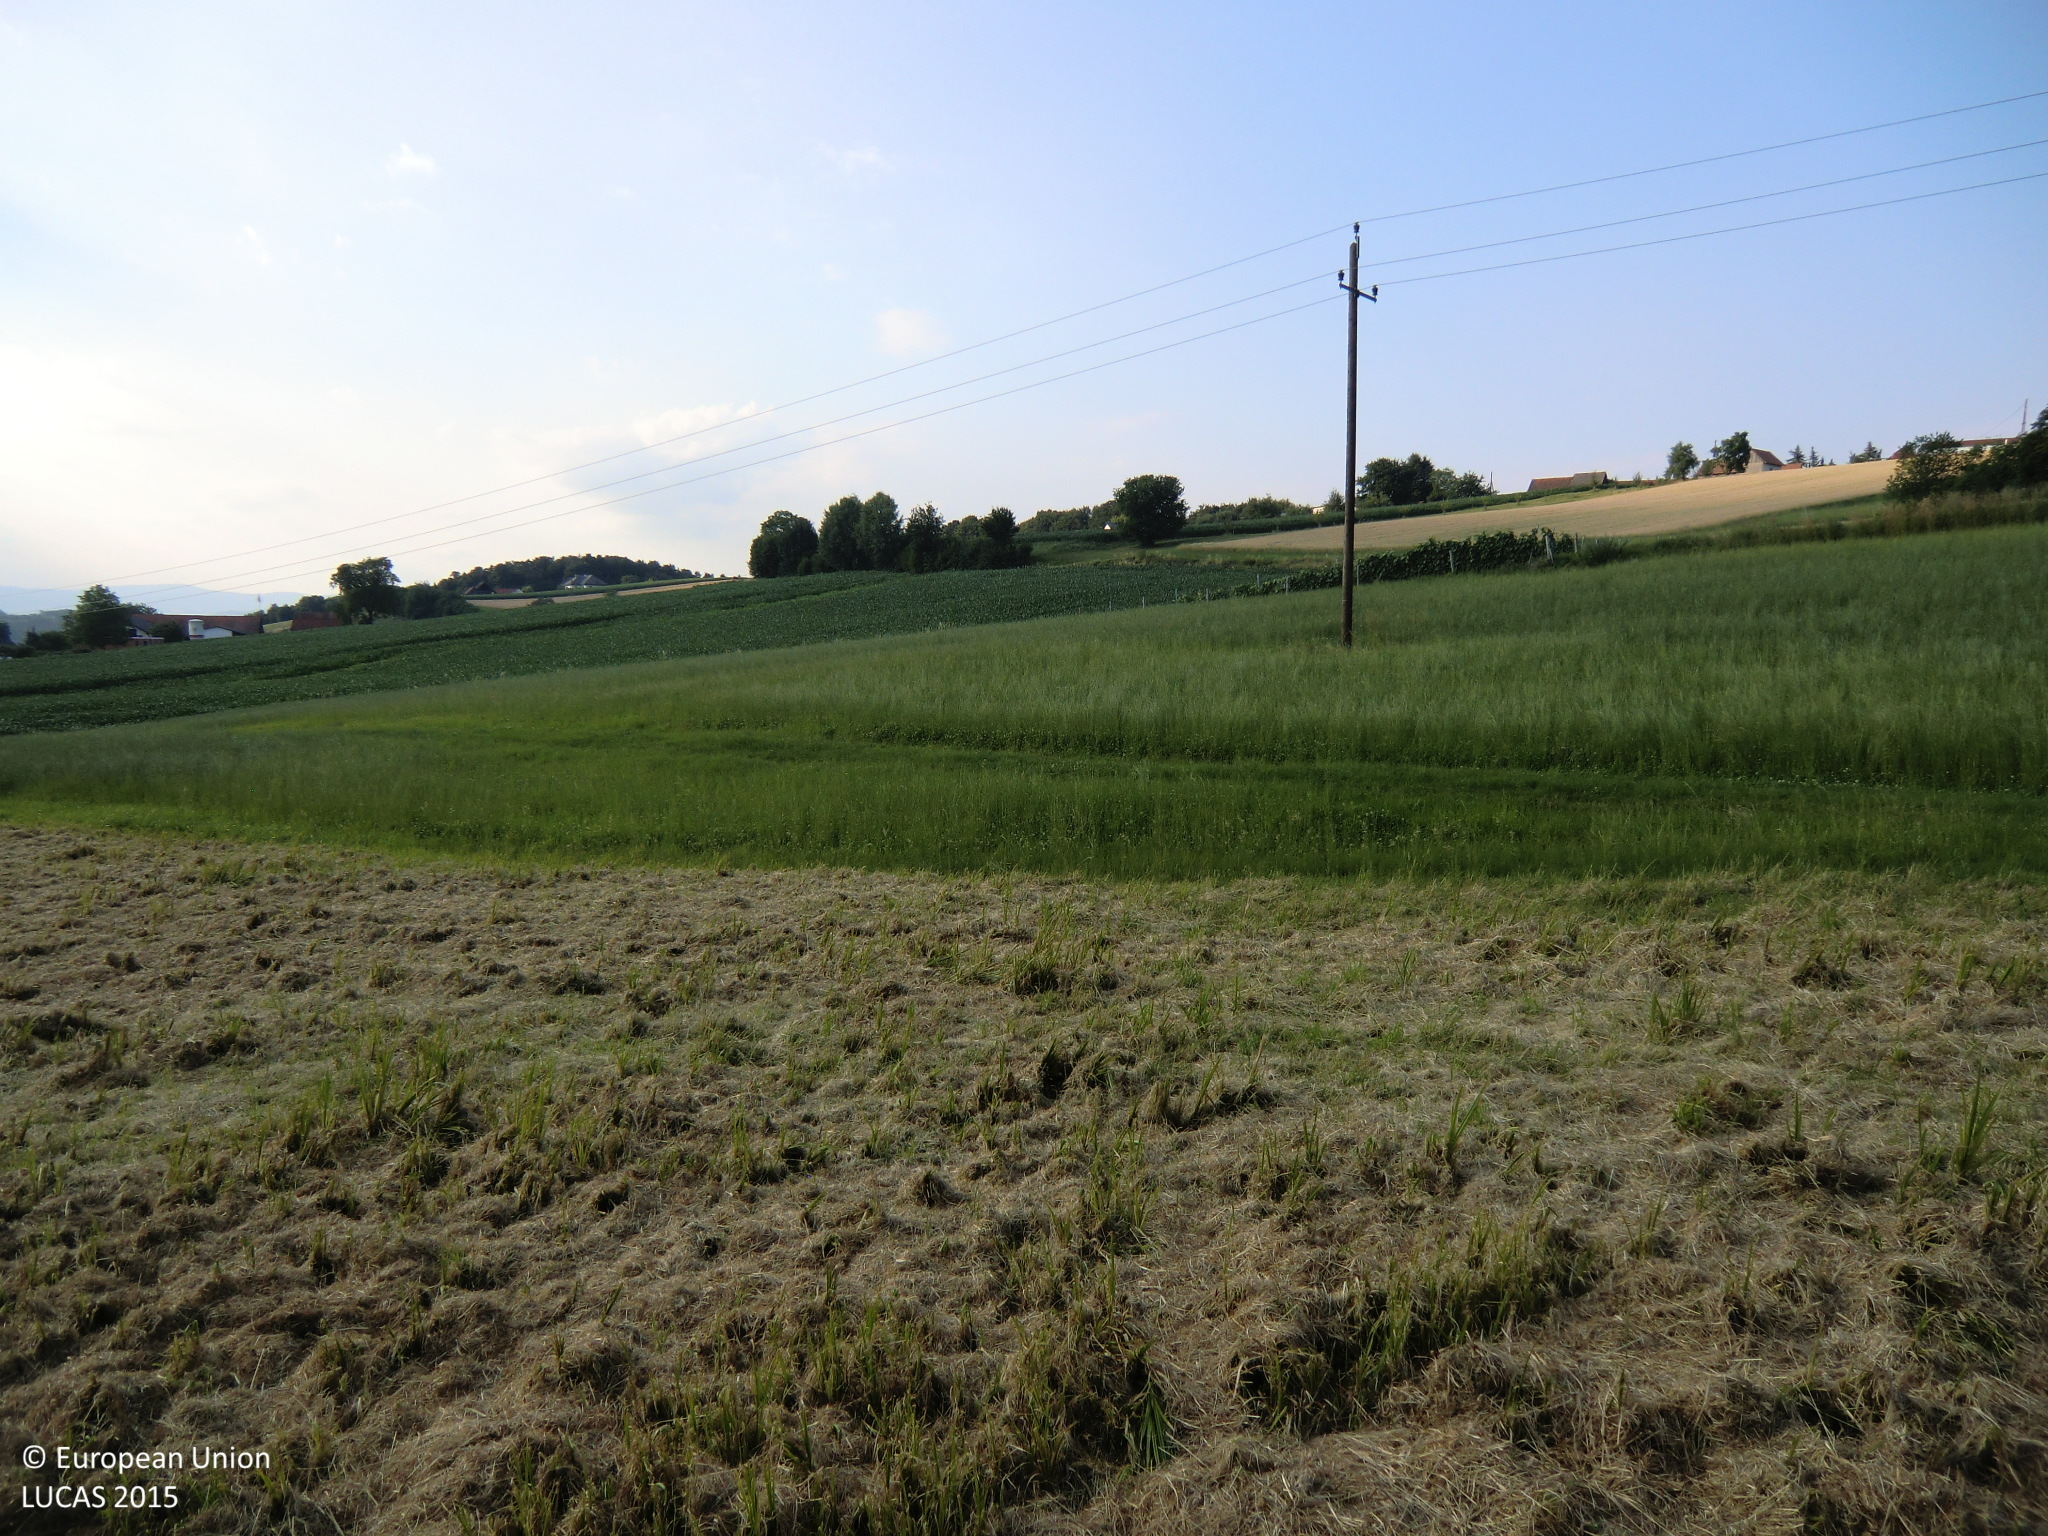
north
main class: Grassland
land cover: Grassland without tree/shrub cover
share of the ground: > 75 %
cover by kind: herbaceous plants 100 %
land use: Agriculture (excluding fallow land and kitchen gardens)
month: July
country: AT
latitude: 47.1799
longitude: 15.9260
